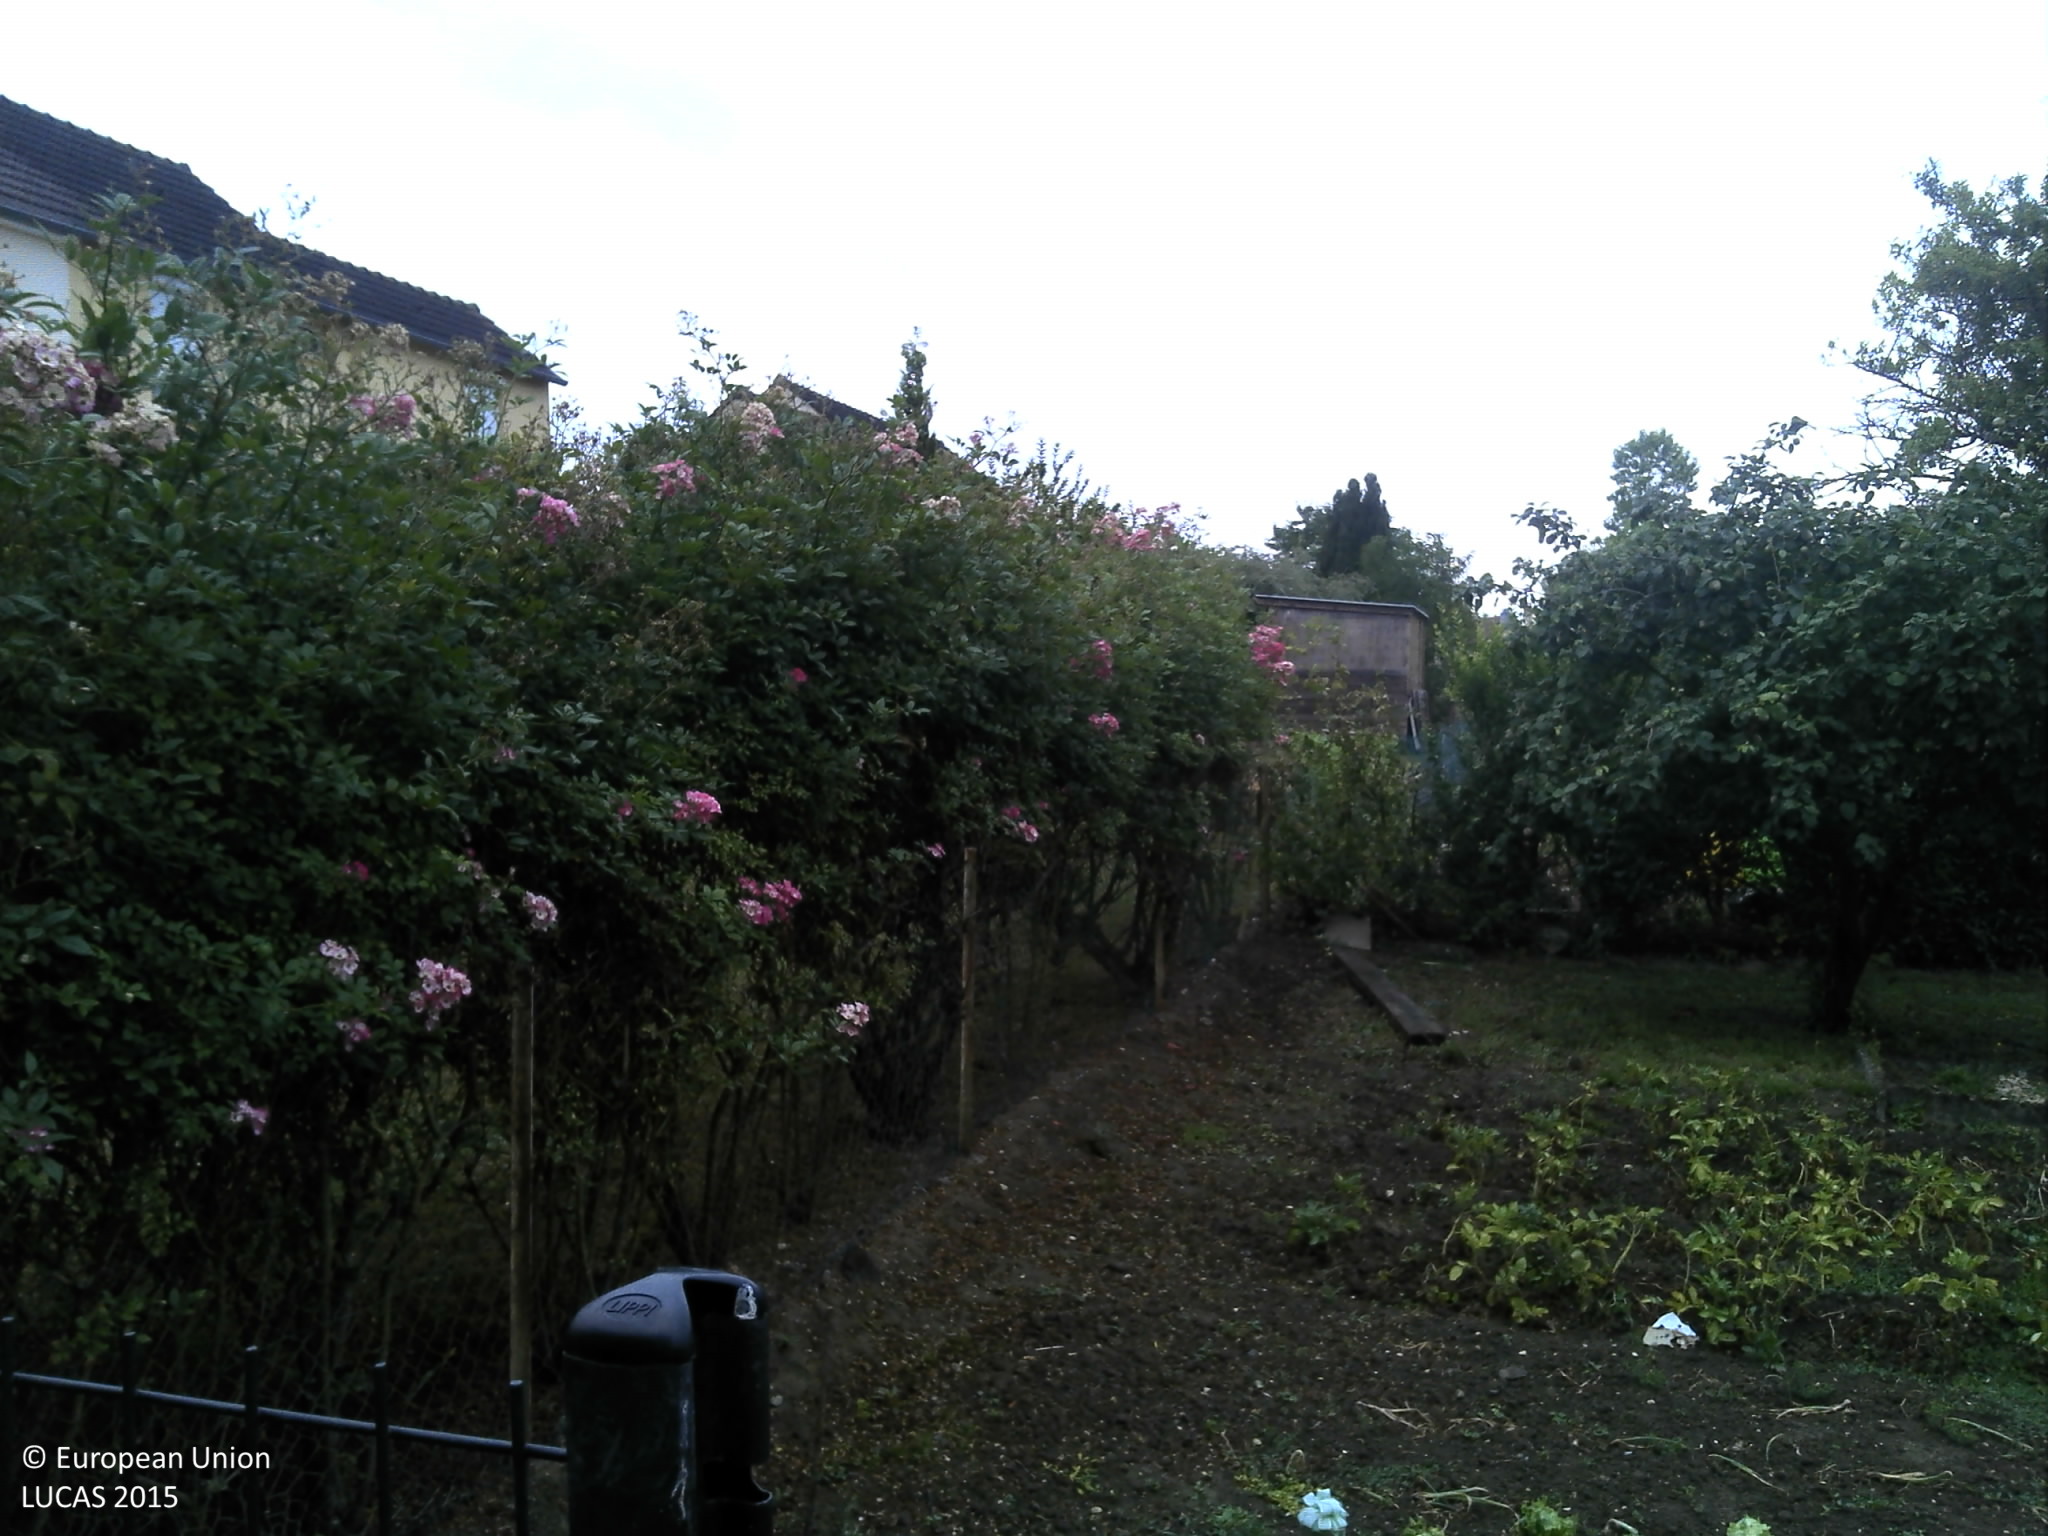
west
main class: Grassland
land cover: Grassland with sparse tree/shrub cover
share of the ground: > 75 %
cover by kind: herbaceous plants 95 %, broadleaved forest trees 5 %
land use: Residential
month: July
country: FR
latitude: 49.3938
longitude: 4.6923
